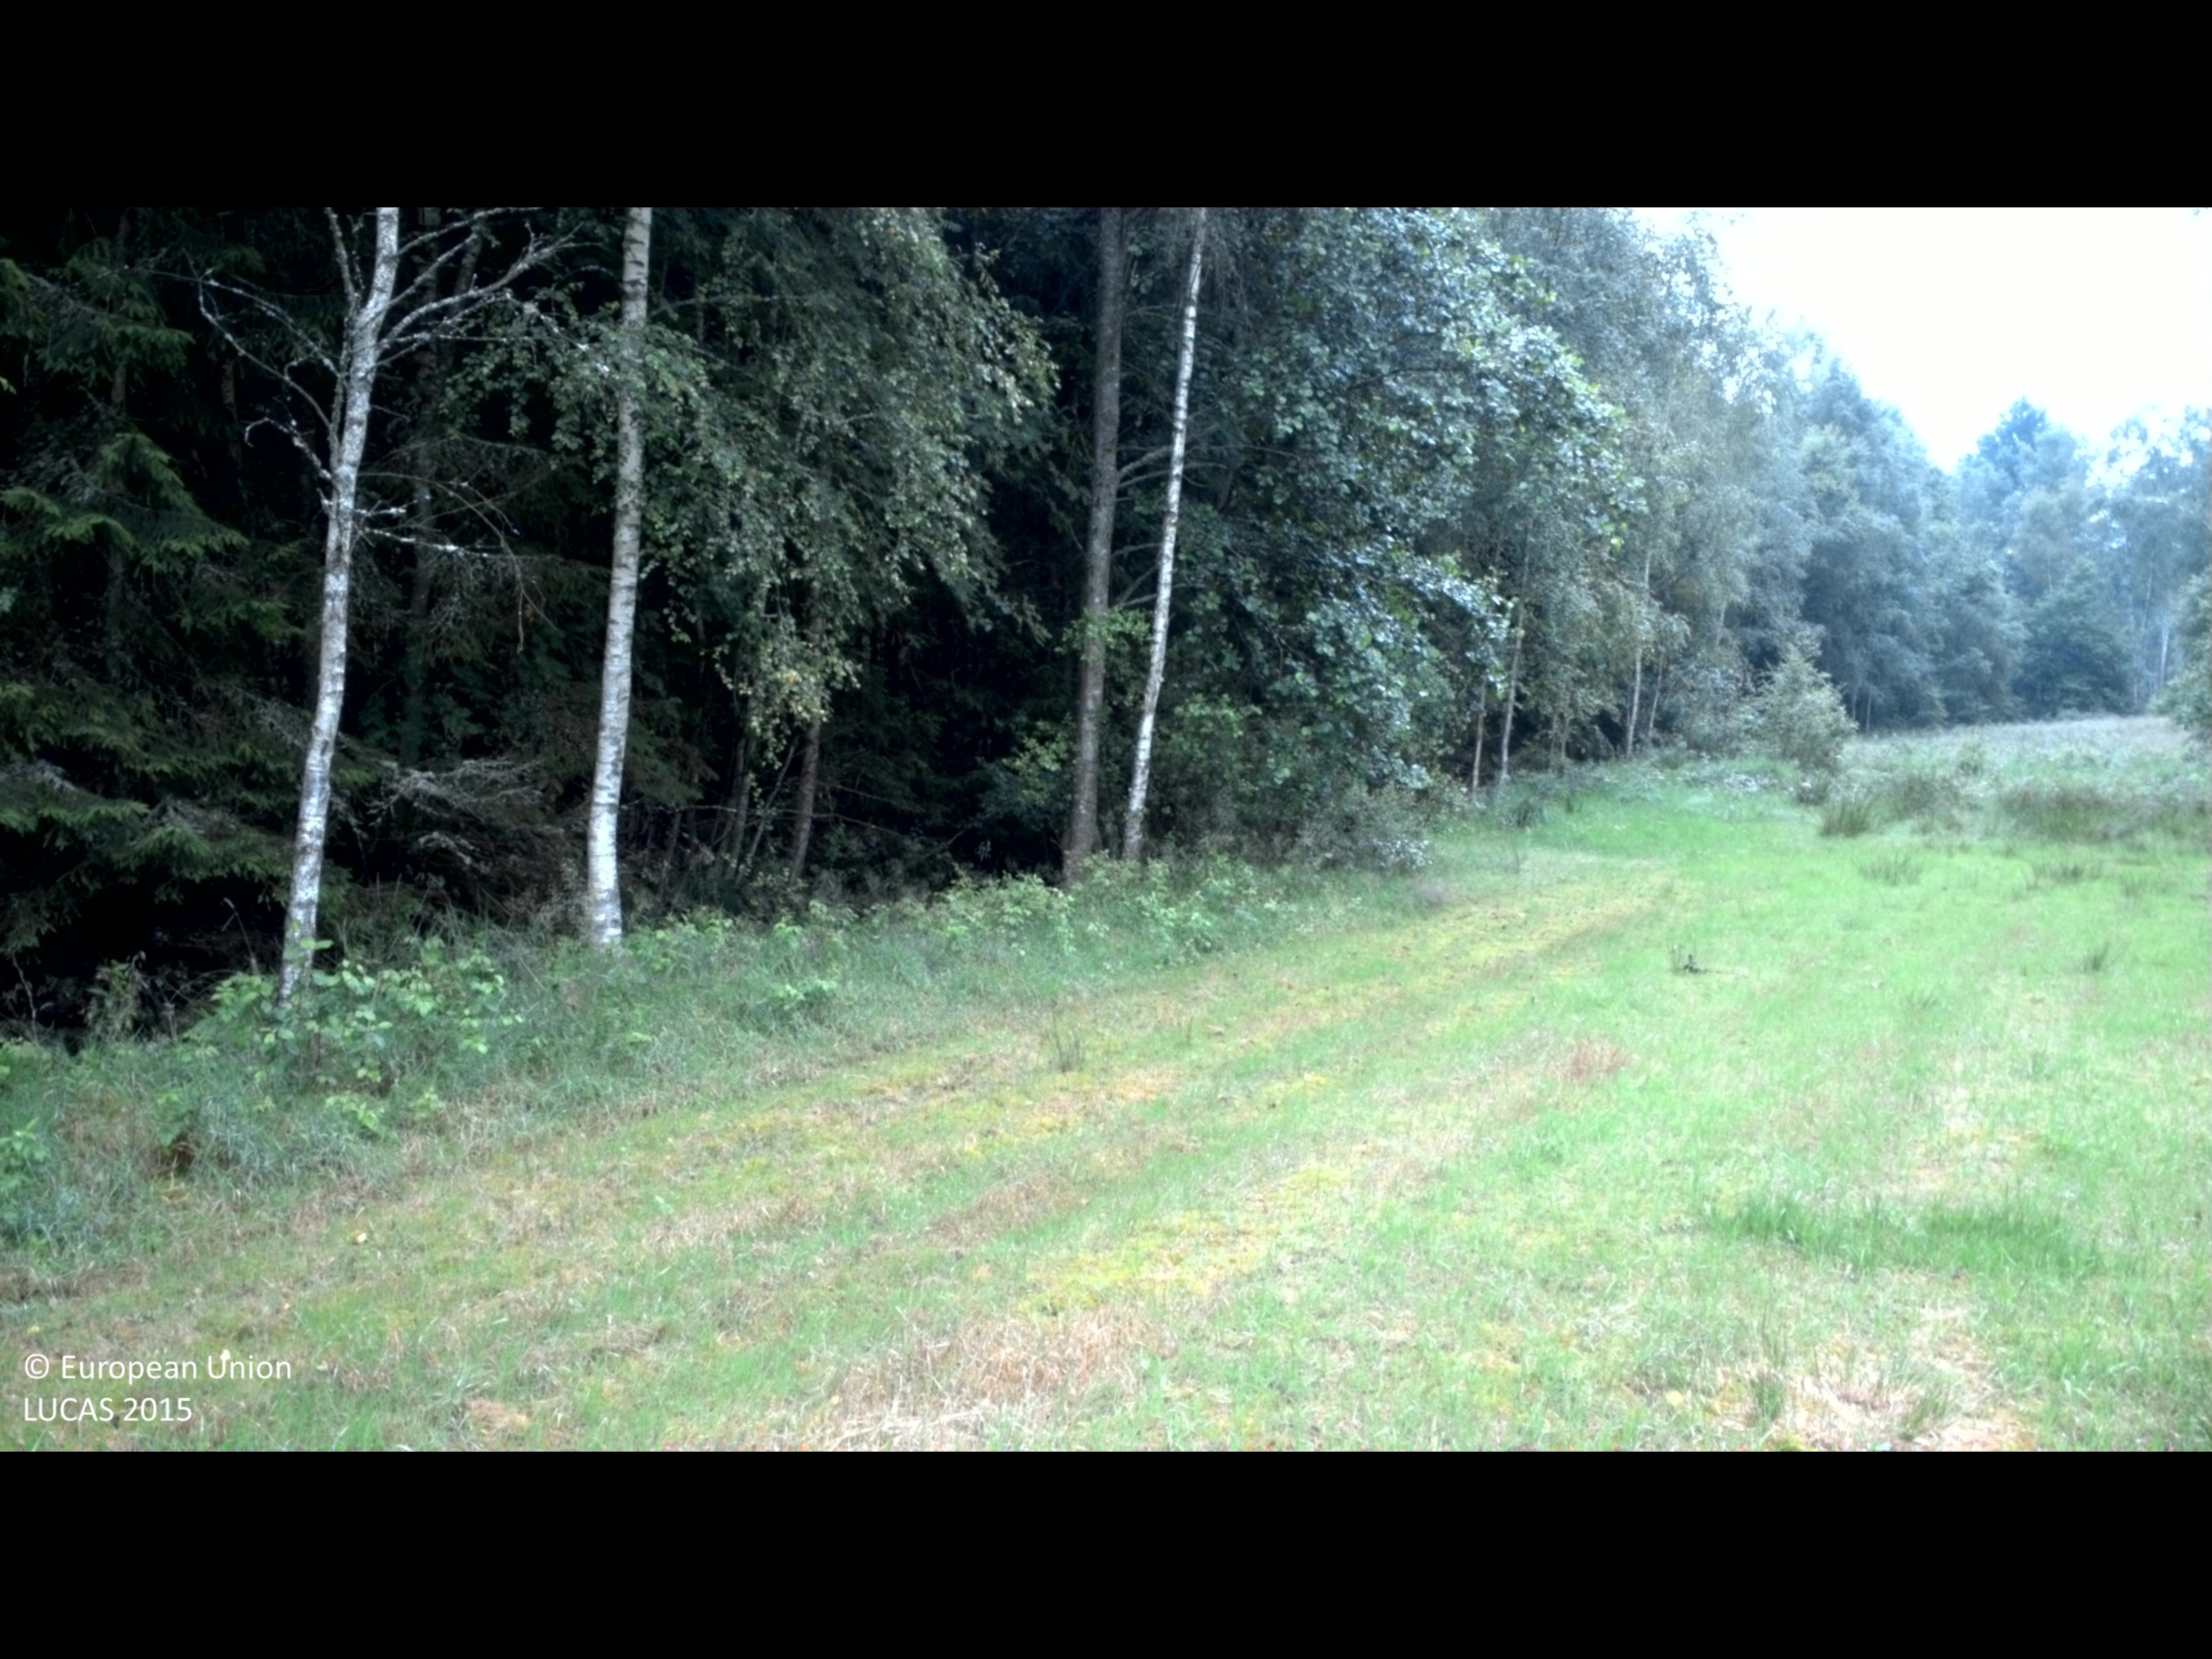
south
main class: Grassland
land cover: Grassland without tree/shrub cover
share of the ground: 50 - 75 %
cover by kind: herbaceous plants 60 %, lichens and mosses 40 %
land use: Agriculture (excluding fallow land and kitchen gardens)
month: July
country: SE
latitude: 56.4843
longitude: 14.0406
